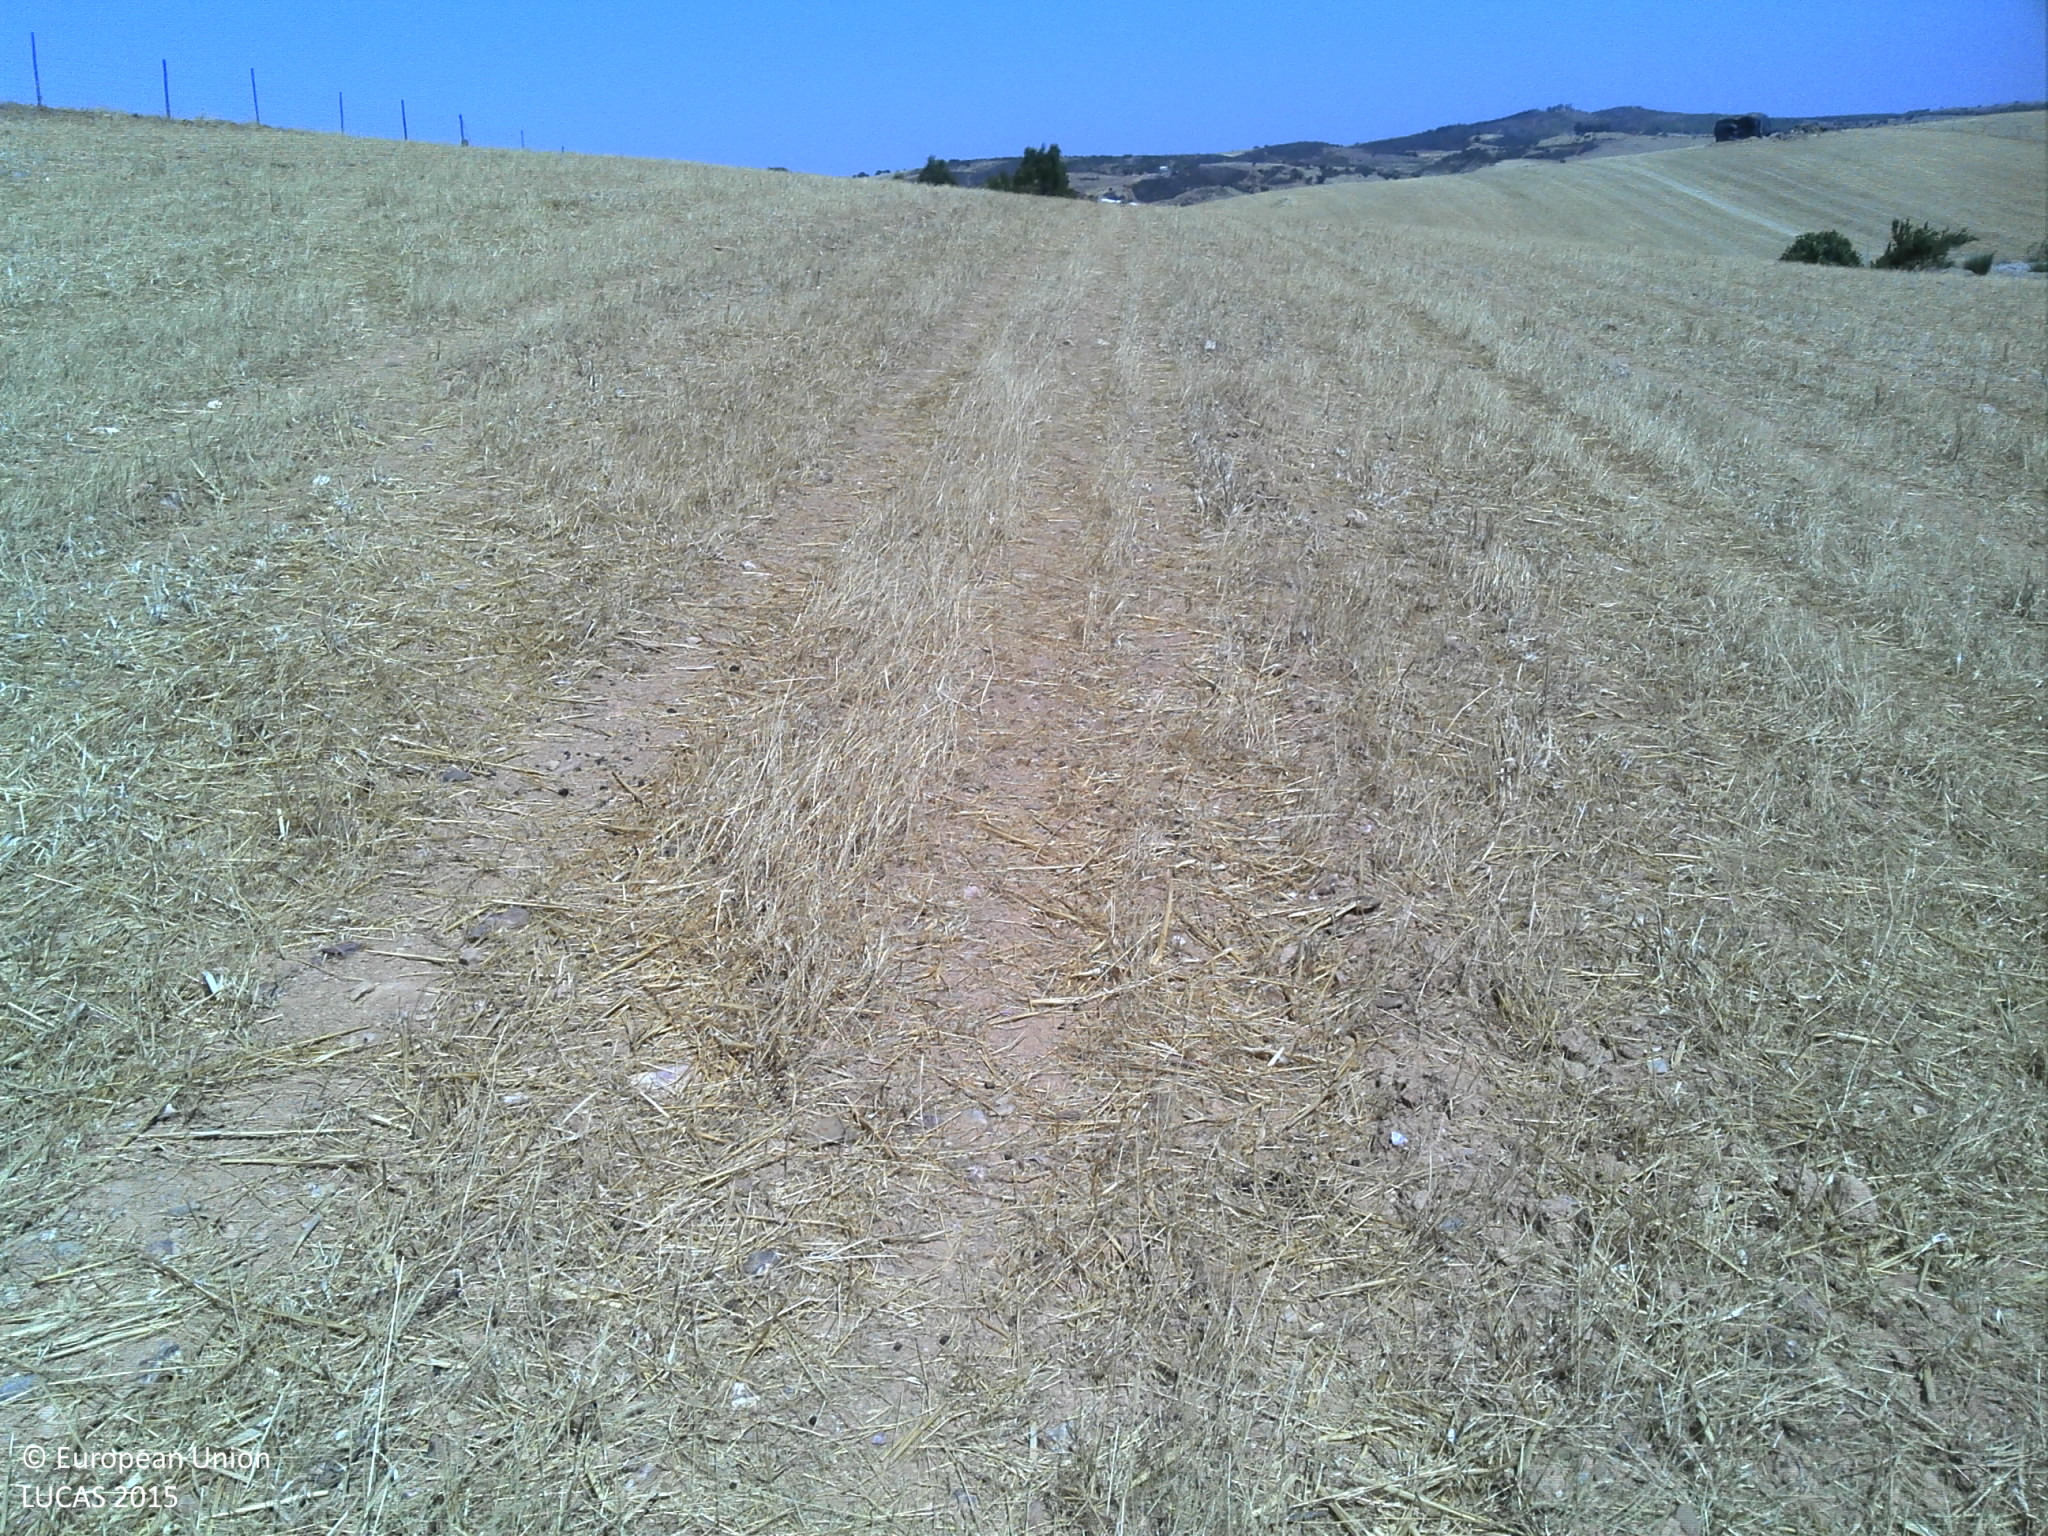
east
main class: Grassland
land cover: Spontaneously vegetated surfaces
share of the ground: 50 - 75 %
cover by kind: herbaceous plants 75 %, unconsolidated bare surface 25 %
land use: Agriculture (excluding fallow land and kitchen gardens)
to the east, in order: Spontaneously vegetated surfaces; Fences; Other structural elements; Rivers and streams; Broadleaved woodland; Other bare soil
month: July
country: PT
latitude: 37.7645
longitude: -7.9490
